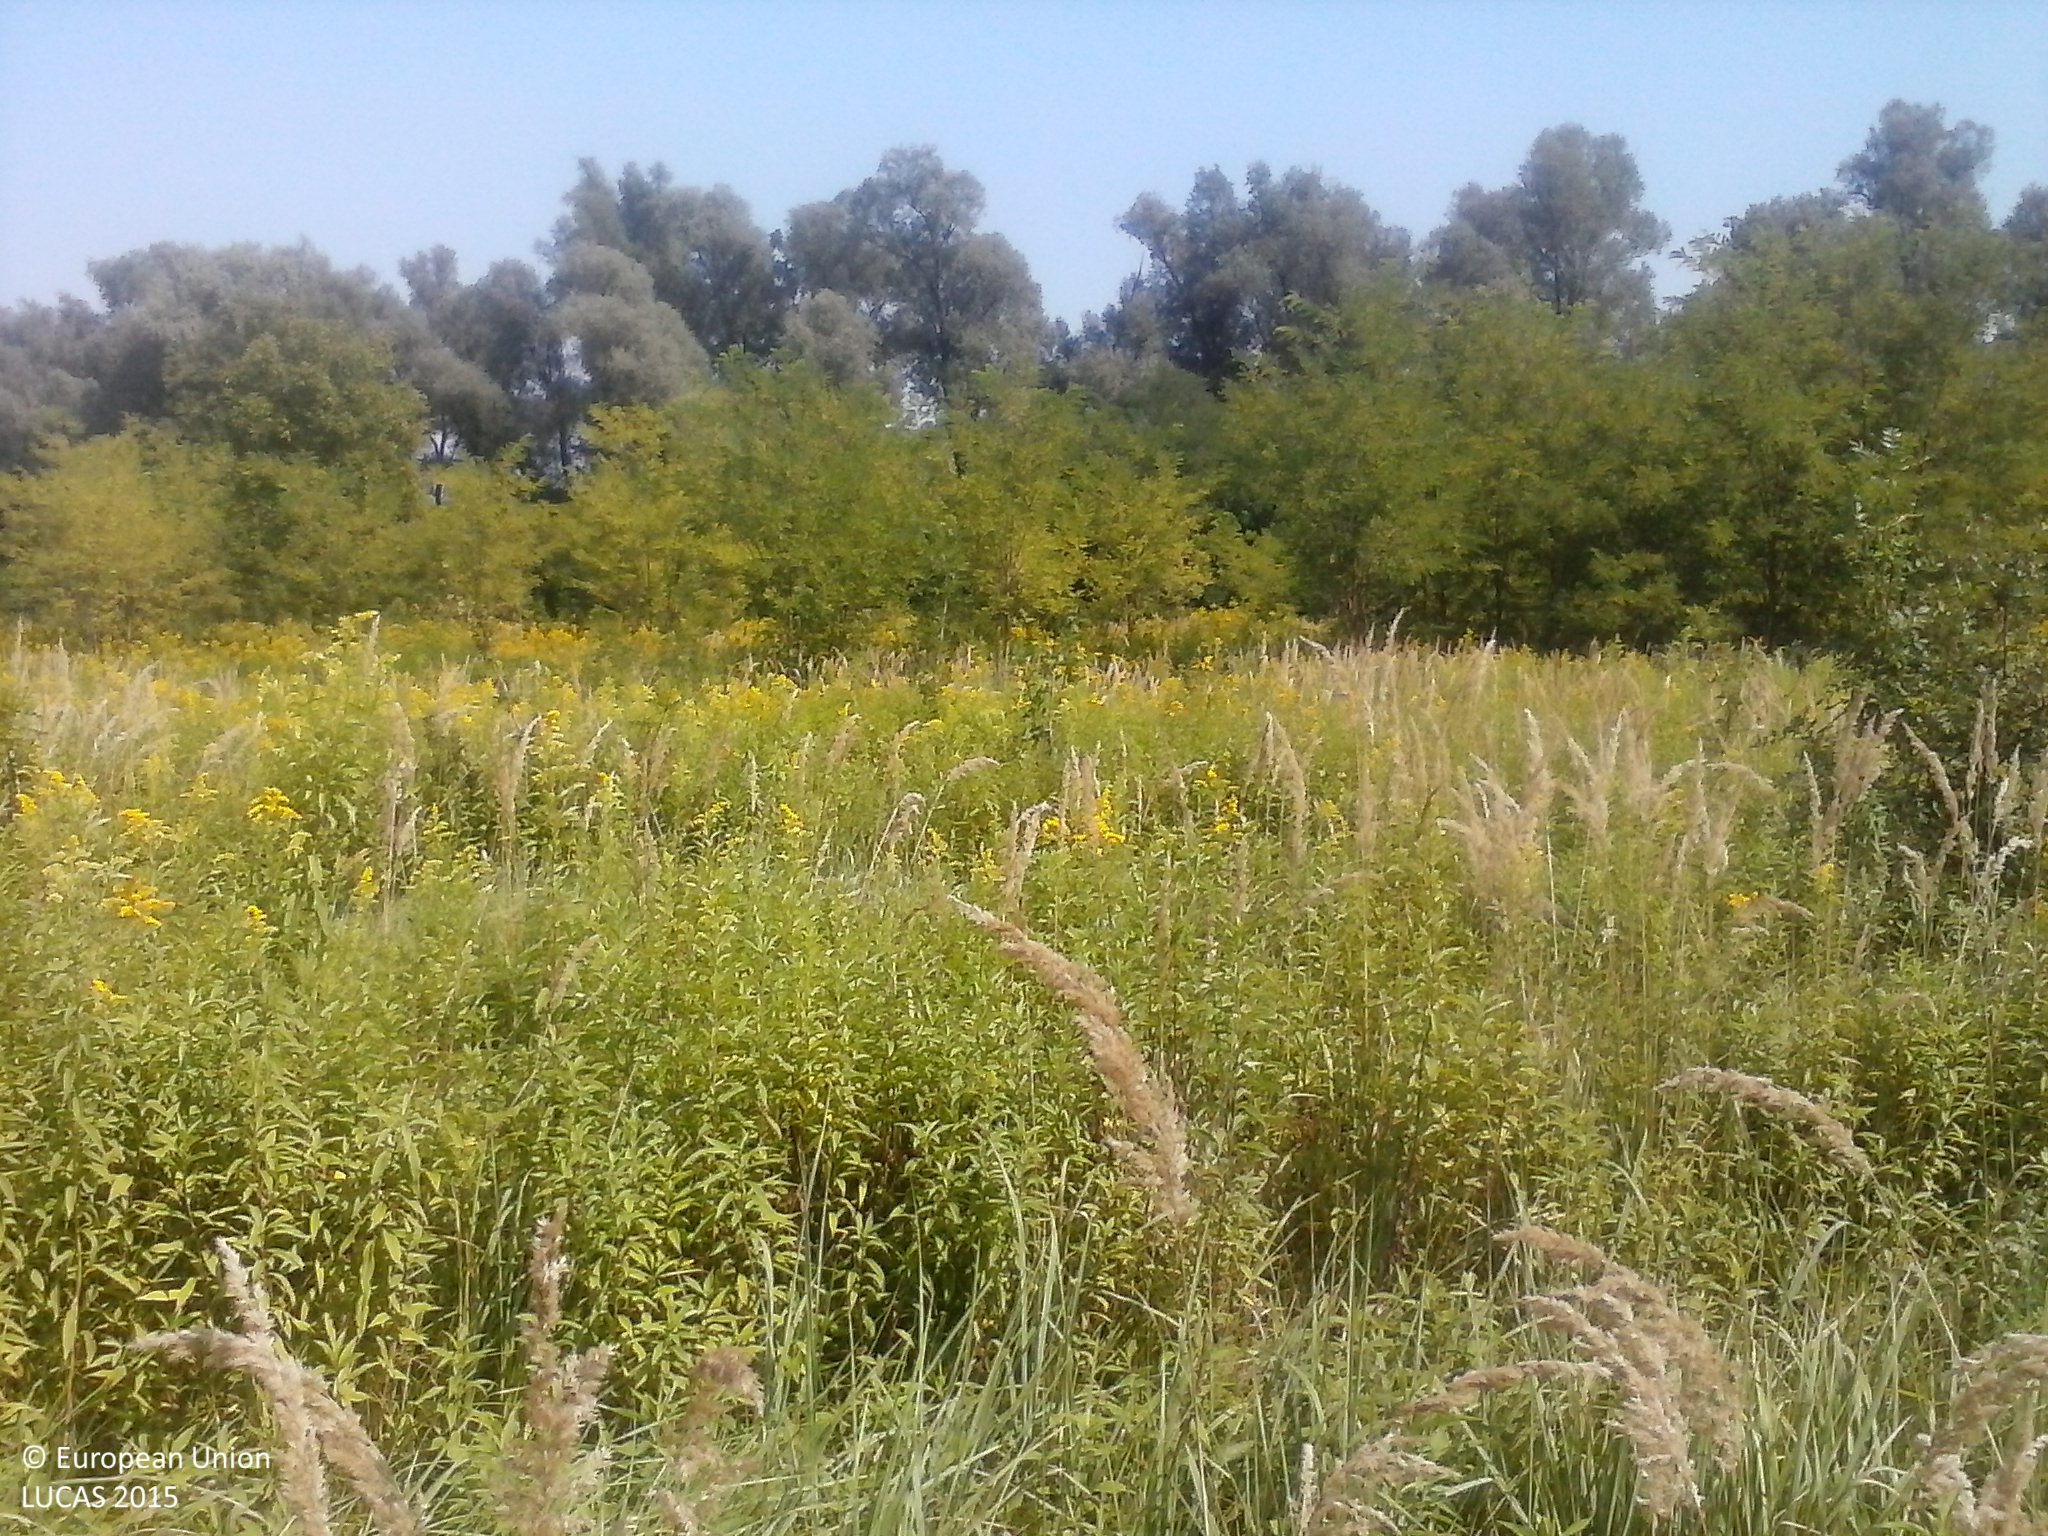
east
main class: Woodland
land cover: Broadleaved woodland
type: acidophilous oak and oak-birch forest
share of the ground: 10 - 25 %
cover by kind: herbaceous plants 80 %, broadleaved forest trees 10 %, shrubs 10 %
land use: Forestry
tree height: < 5 m
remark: Nursery
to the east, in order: Broadleaved woodland; Grassland with sparse tree/shrub cover; Broadleaved woodland
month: August
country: HU
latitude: 45.8021
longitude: 17.9433
